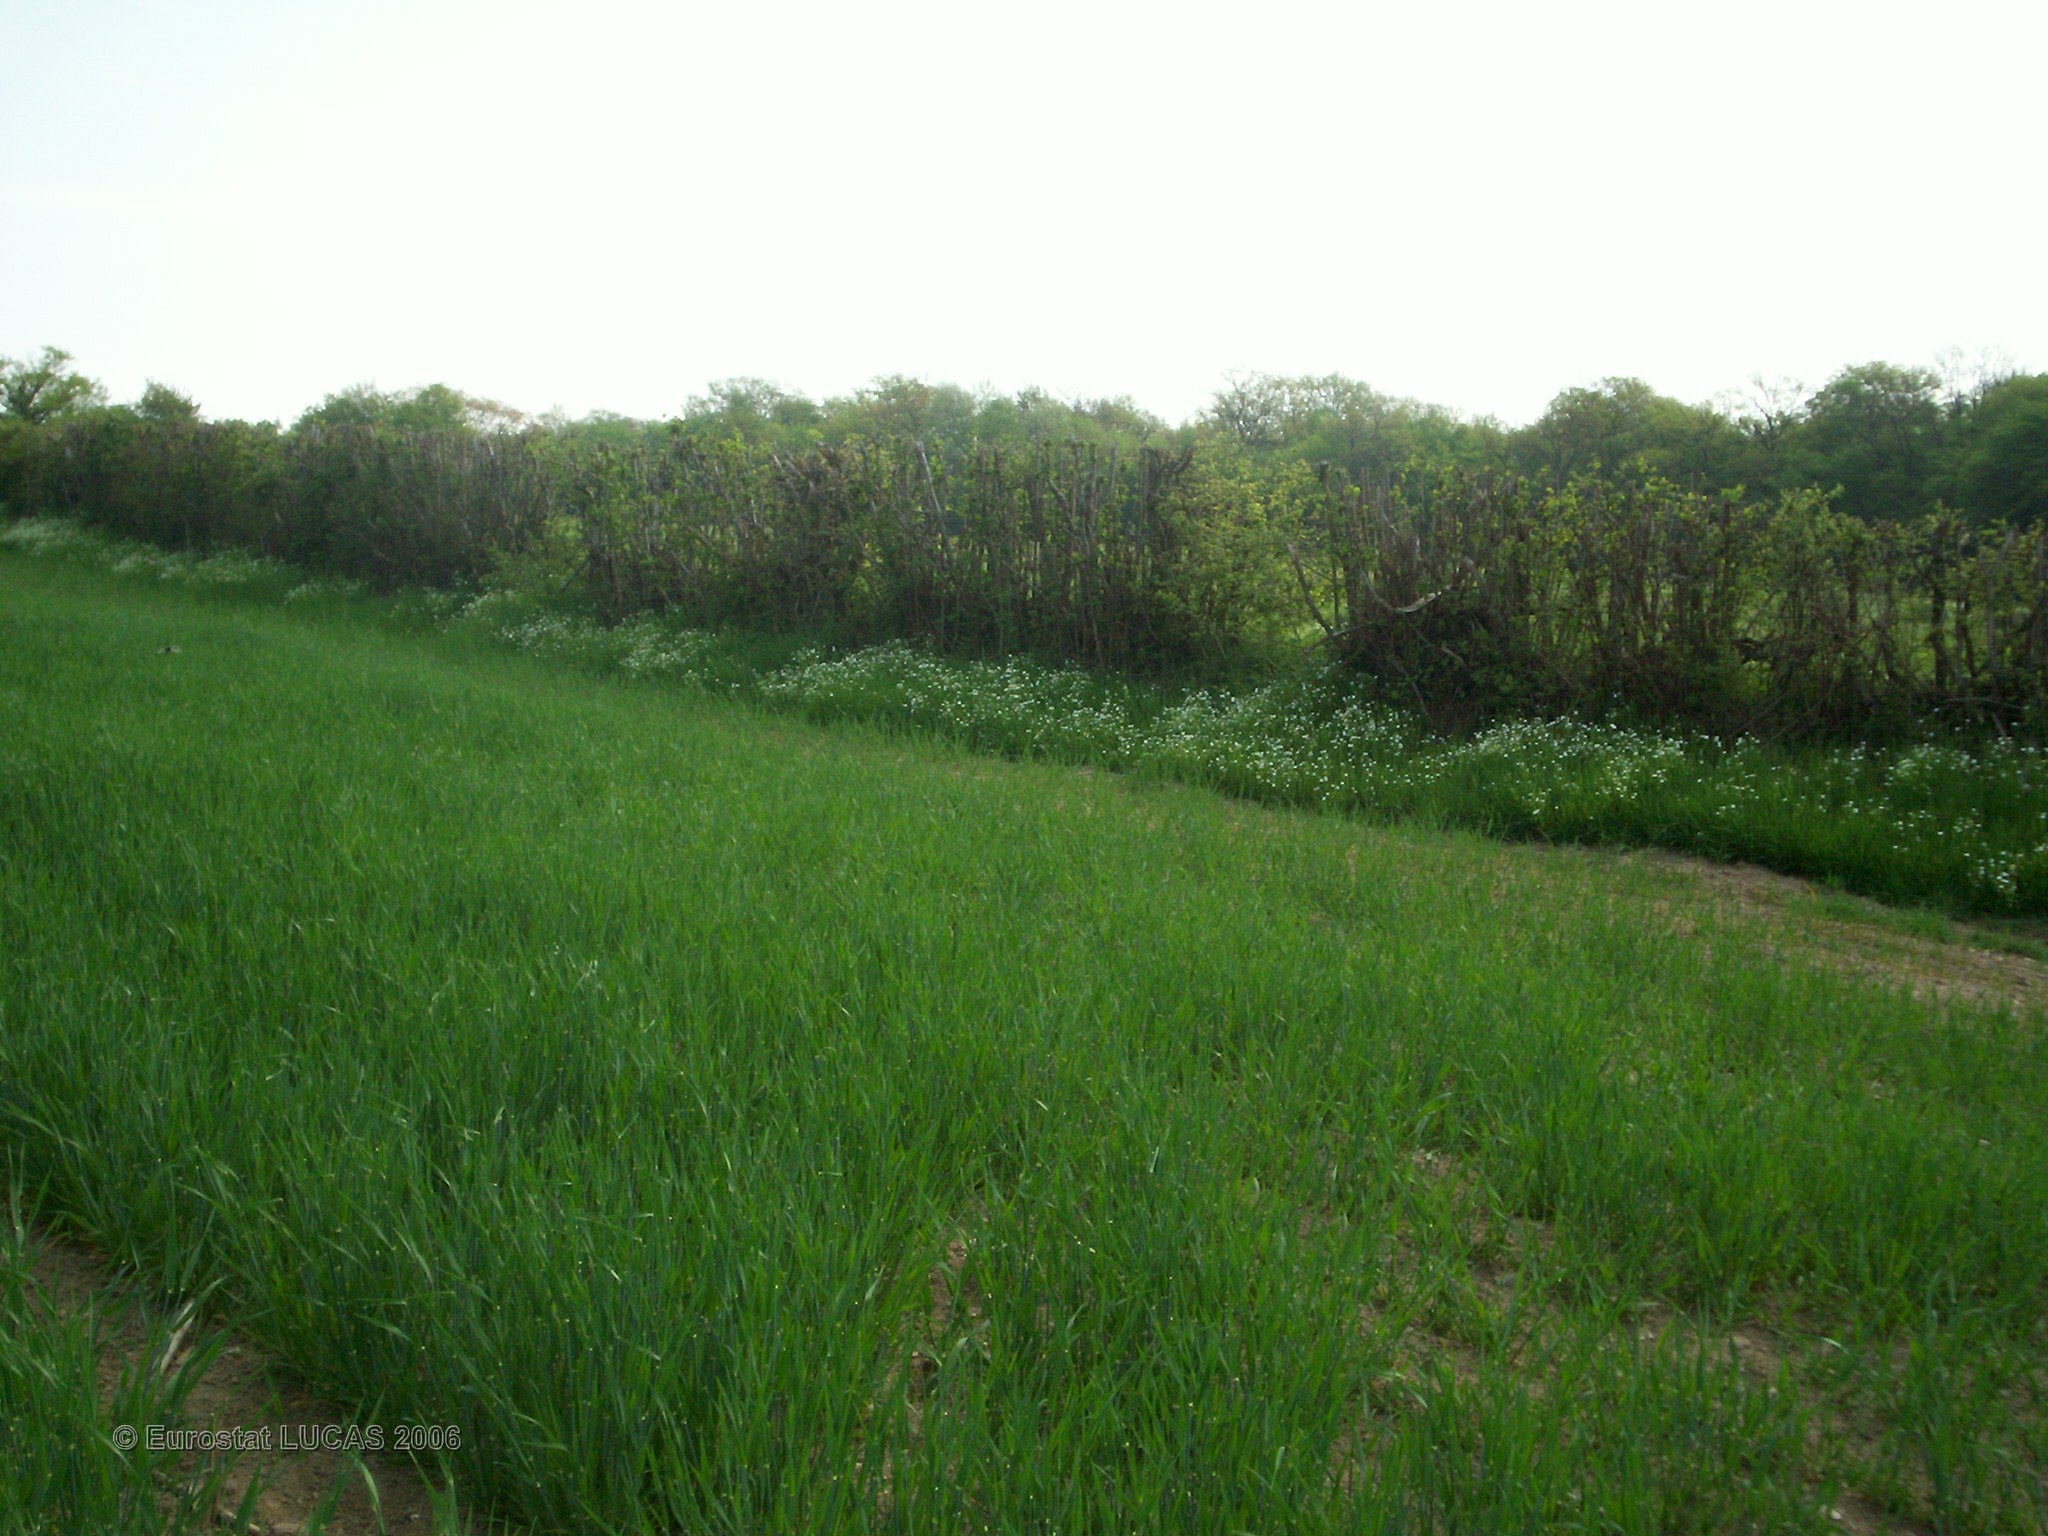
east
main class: Cropland
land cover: Barley
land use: Agriculture (excluding fallow land and kitchen gardens)
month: May
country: FR
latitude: 47.4295
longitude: 4.0189
